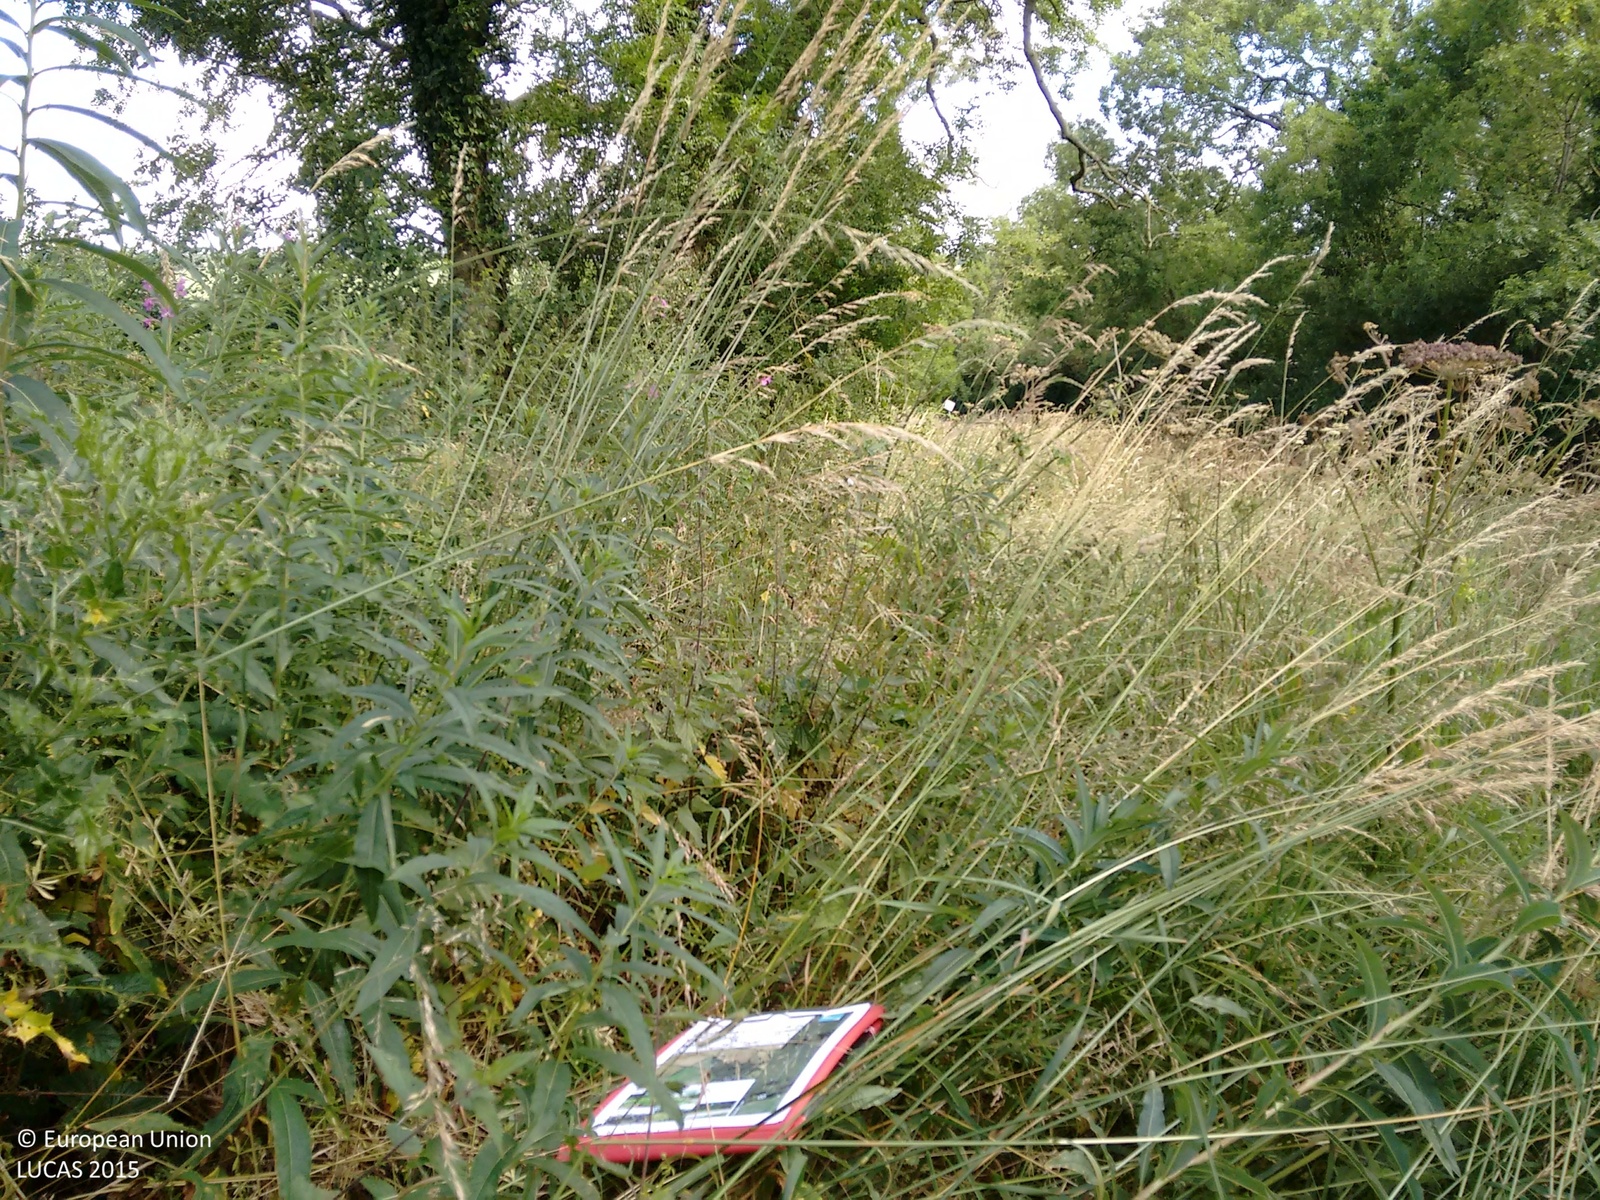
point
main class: Grassland
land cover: Grassland without tree/shrub cover
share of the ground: > 75 %
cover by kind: herbaceous plants 100 %
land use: Semi-natural and natural areas not in use
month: July
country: GB
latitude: 52.6917
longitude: -0.8876
